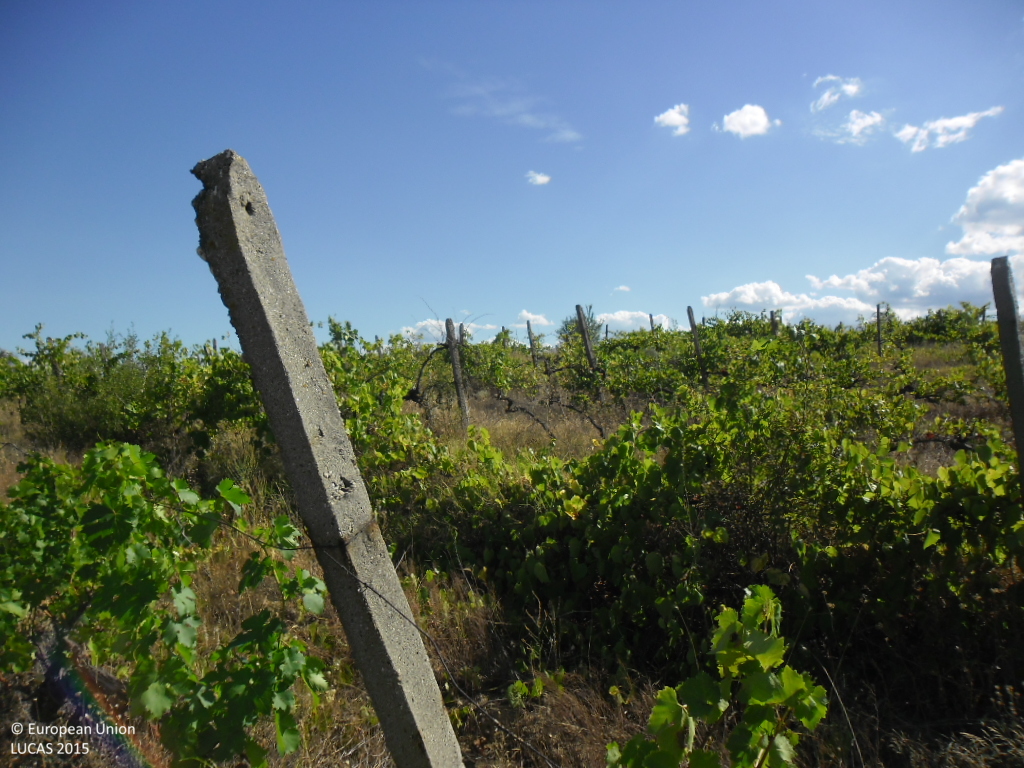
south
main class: Cropland
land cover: Vineyards
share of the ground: 50 - 75 %
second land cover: Spontaneously vegetated surfaces
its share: > 75 %
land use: Agriculture (excluding fallow land and kitchen gardens)
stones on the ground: < 10 %
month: August
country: BG
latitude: 42.0483
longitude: 23.0115
